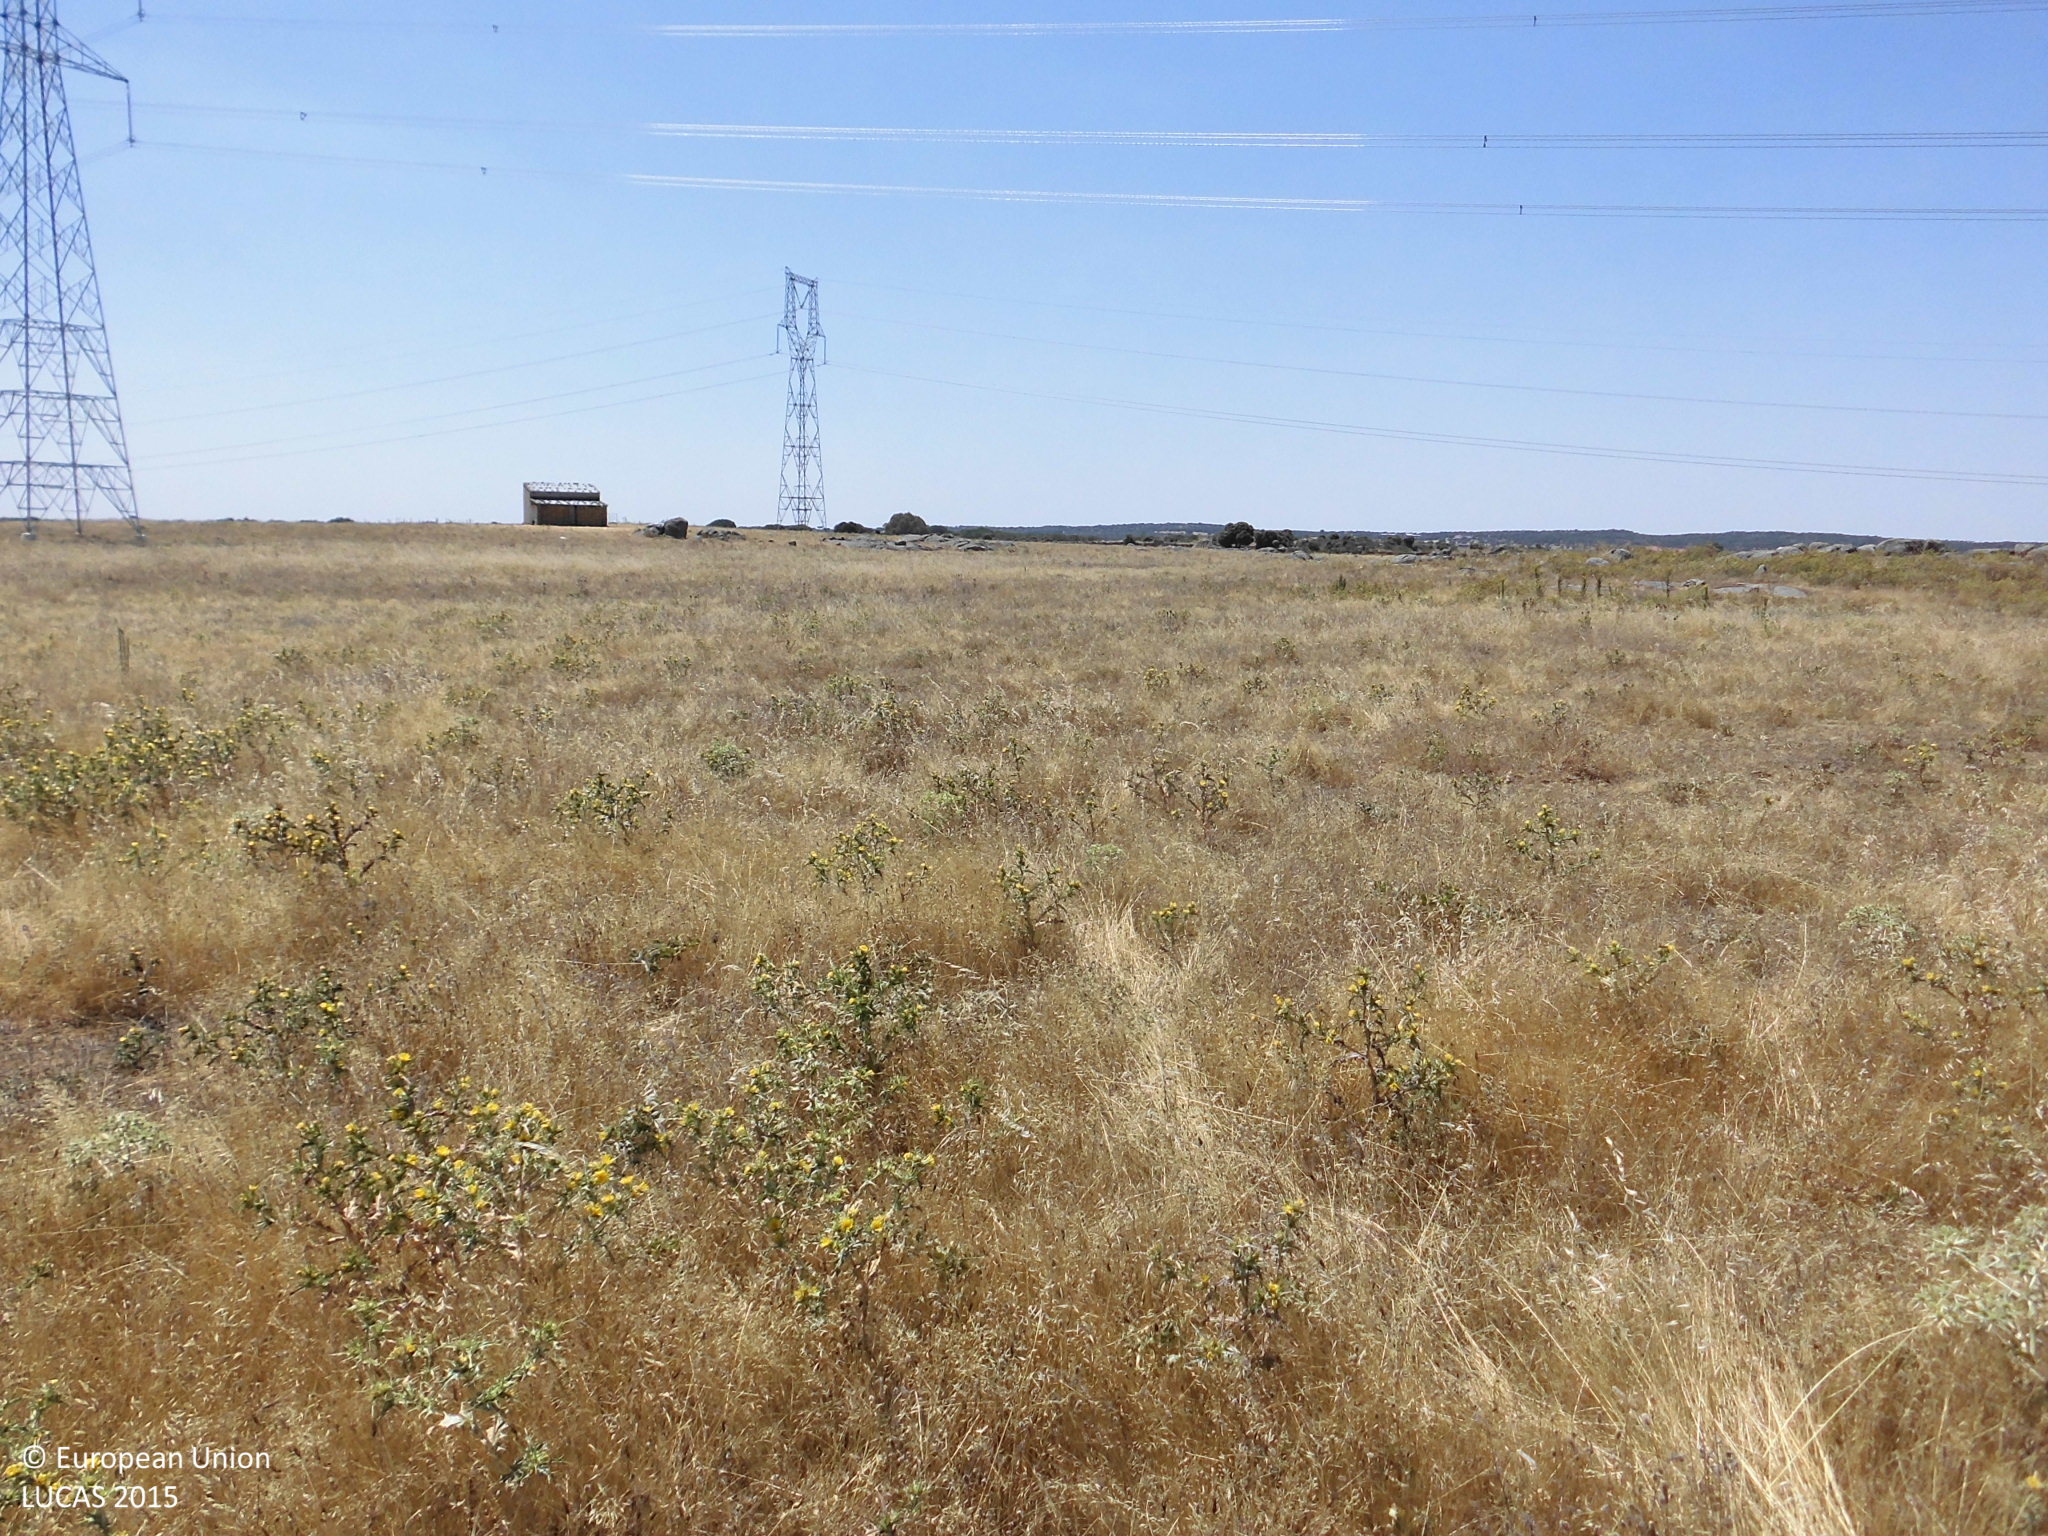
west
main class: Grassland
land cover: Grassland without tree/shrub cover
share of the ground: > 75 %
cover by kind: herbaceous plants 100 %
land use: Agriculture (excluding fallow land and kitchen gardens)
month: June
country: ES
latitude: 39.3725
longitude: -5.9727
